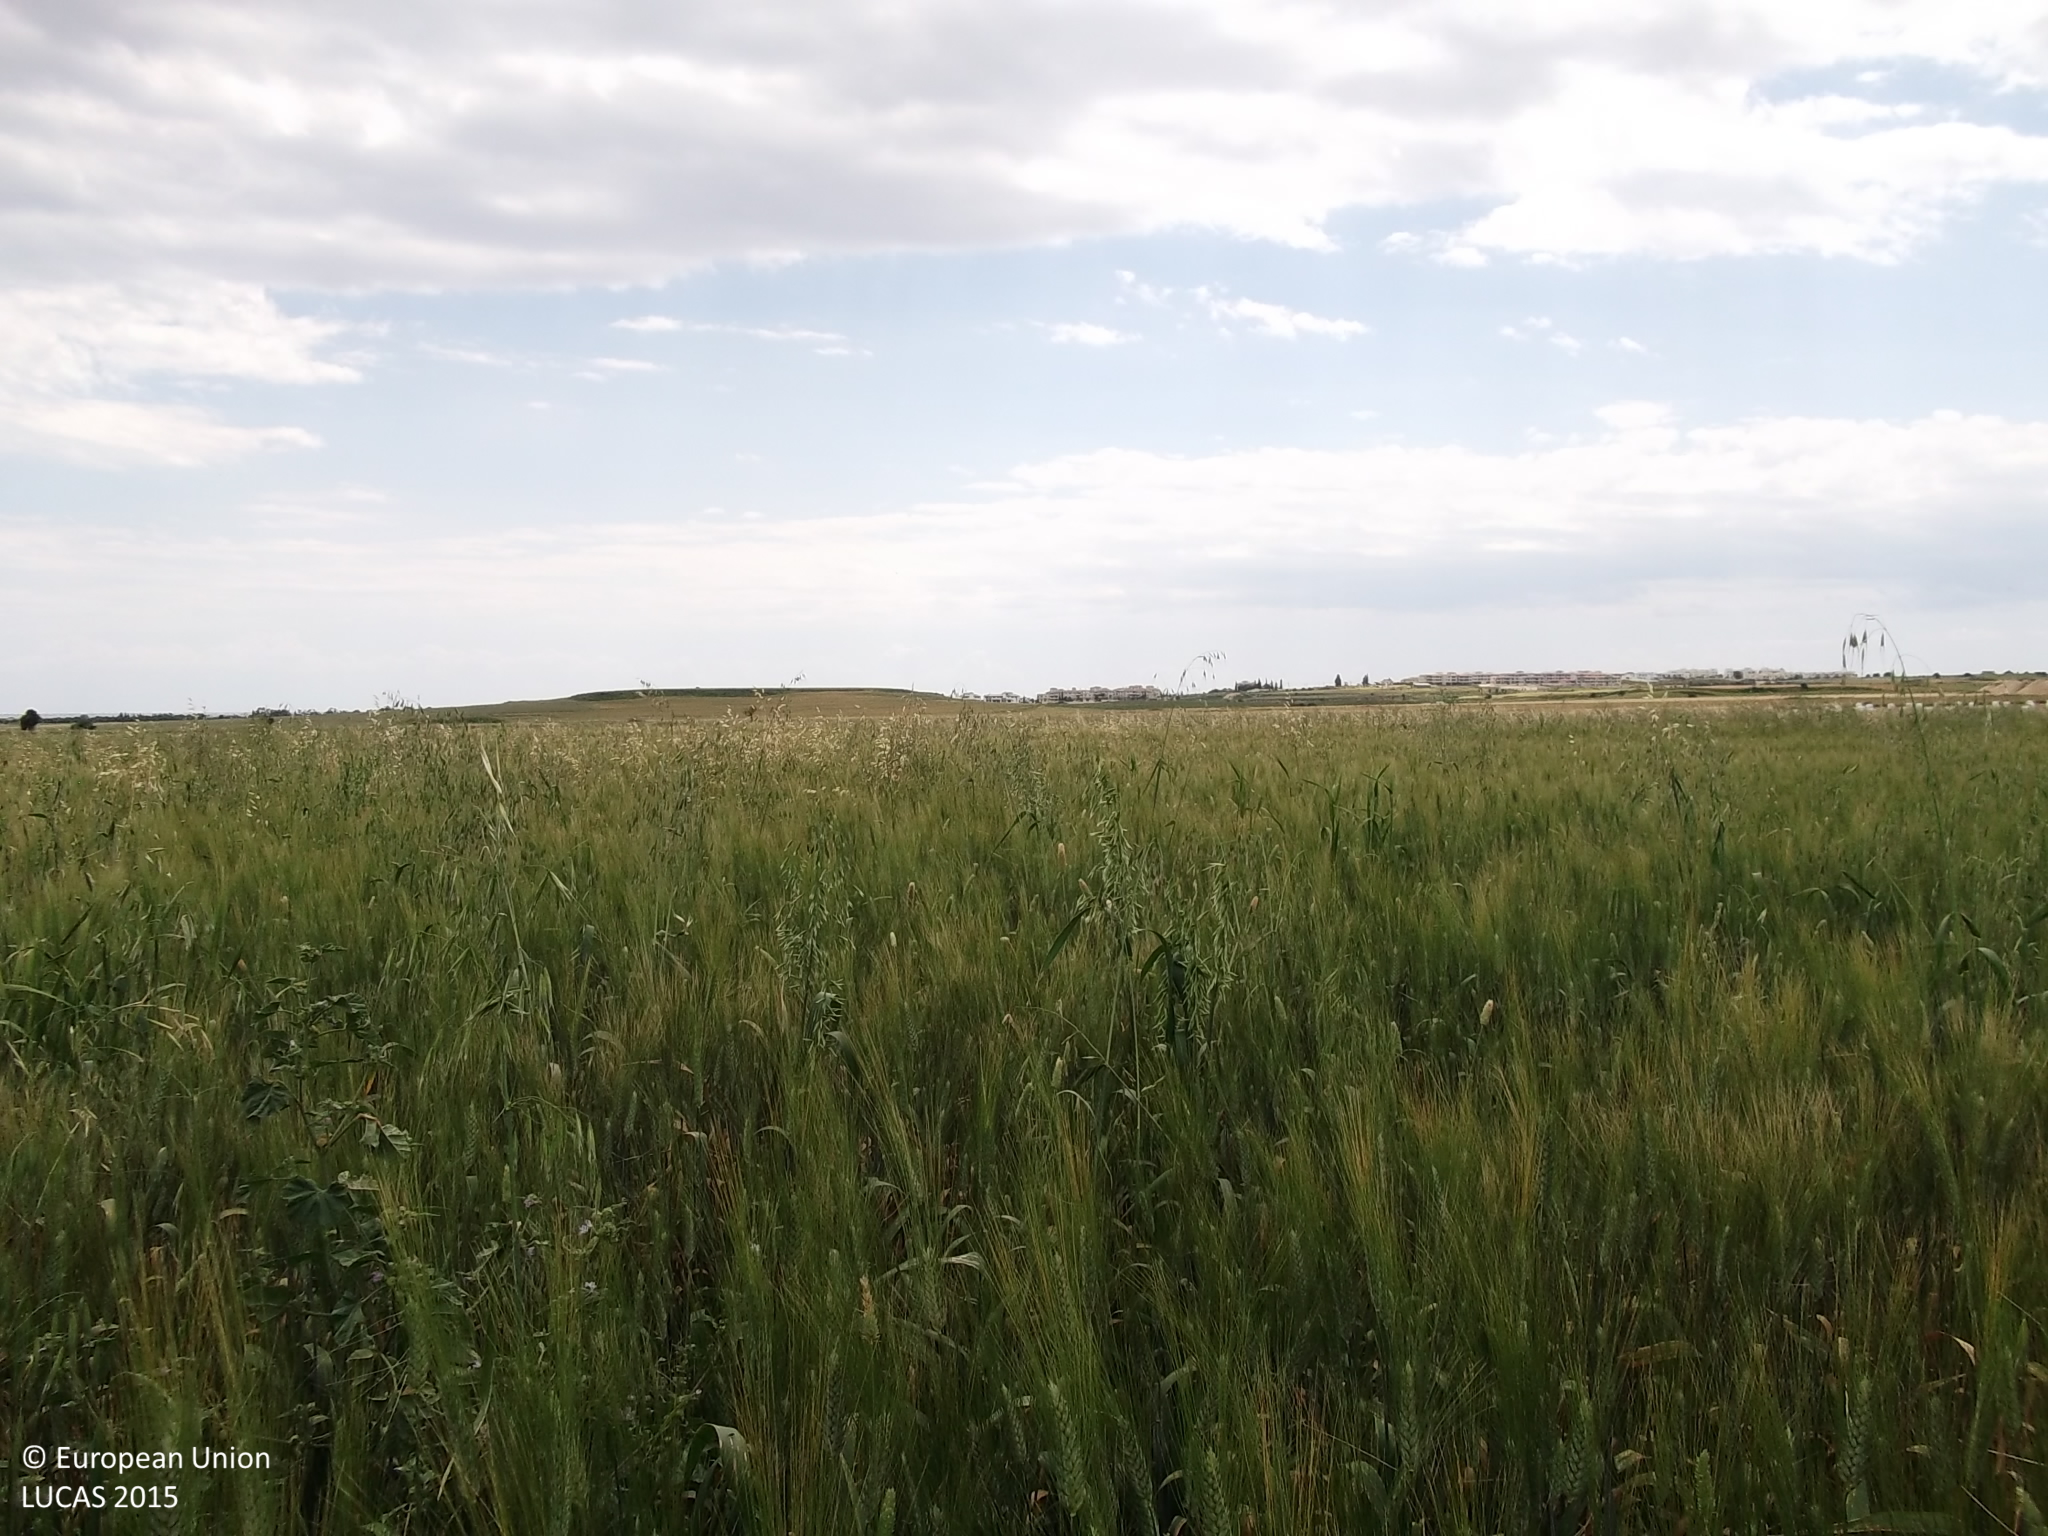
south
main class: Cropland
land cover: Barley
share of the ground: > 75 %
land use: Agriculture (excluding fallow land and kitchen gardens)
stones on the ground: < 10 %
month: April
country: CY
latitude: 34.8769
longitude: 33.5495
